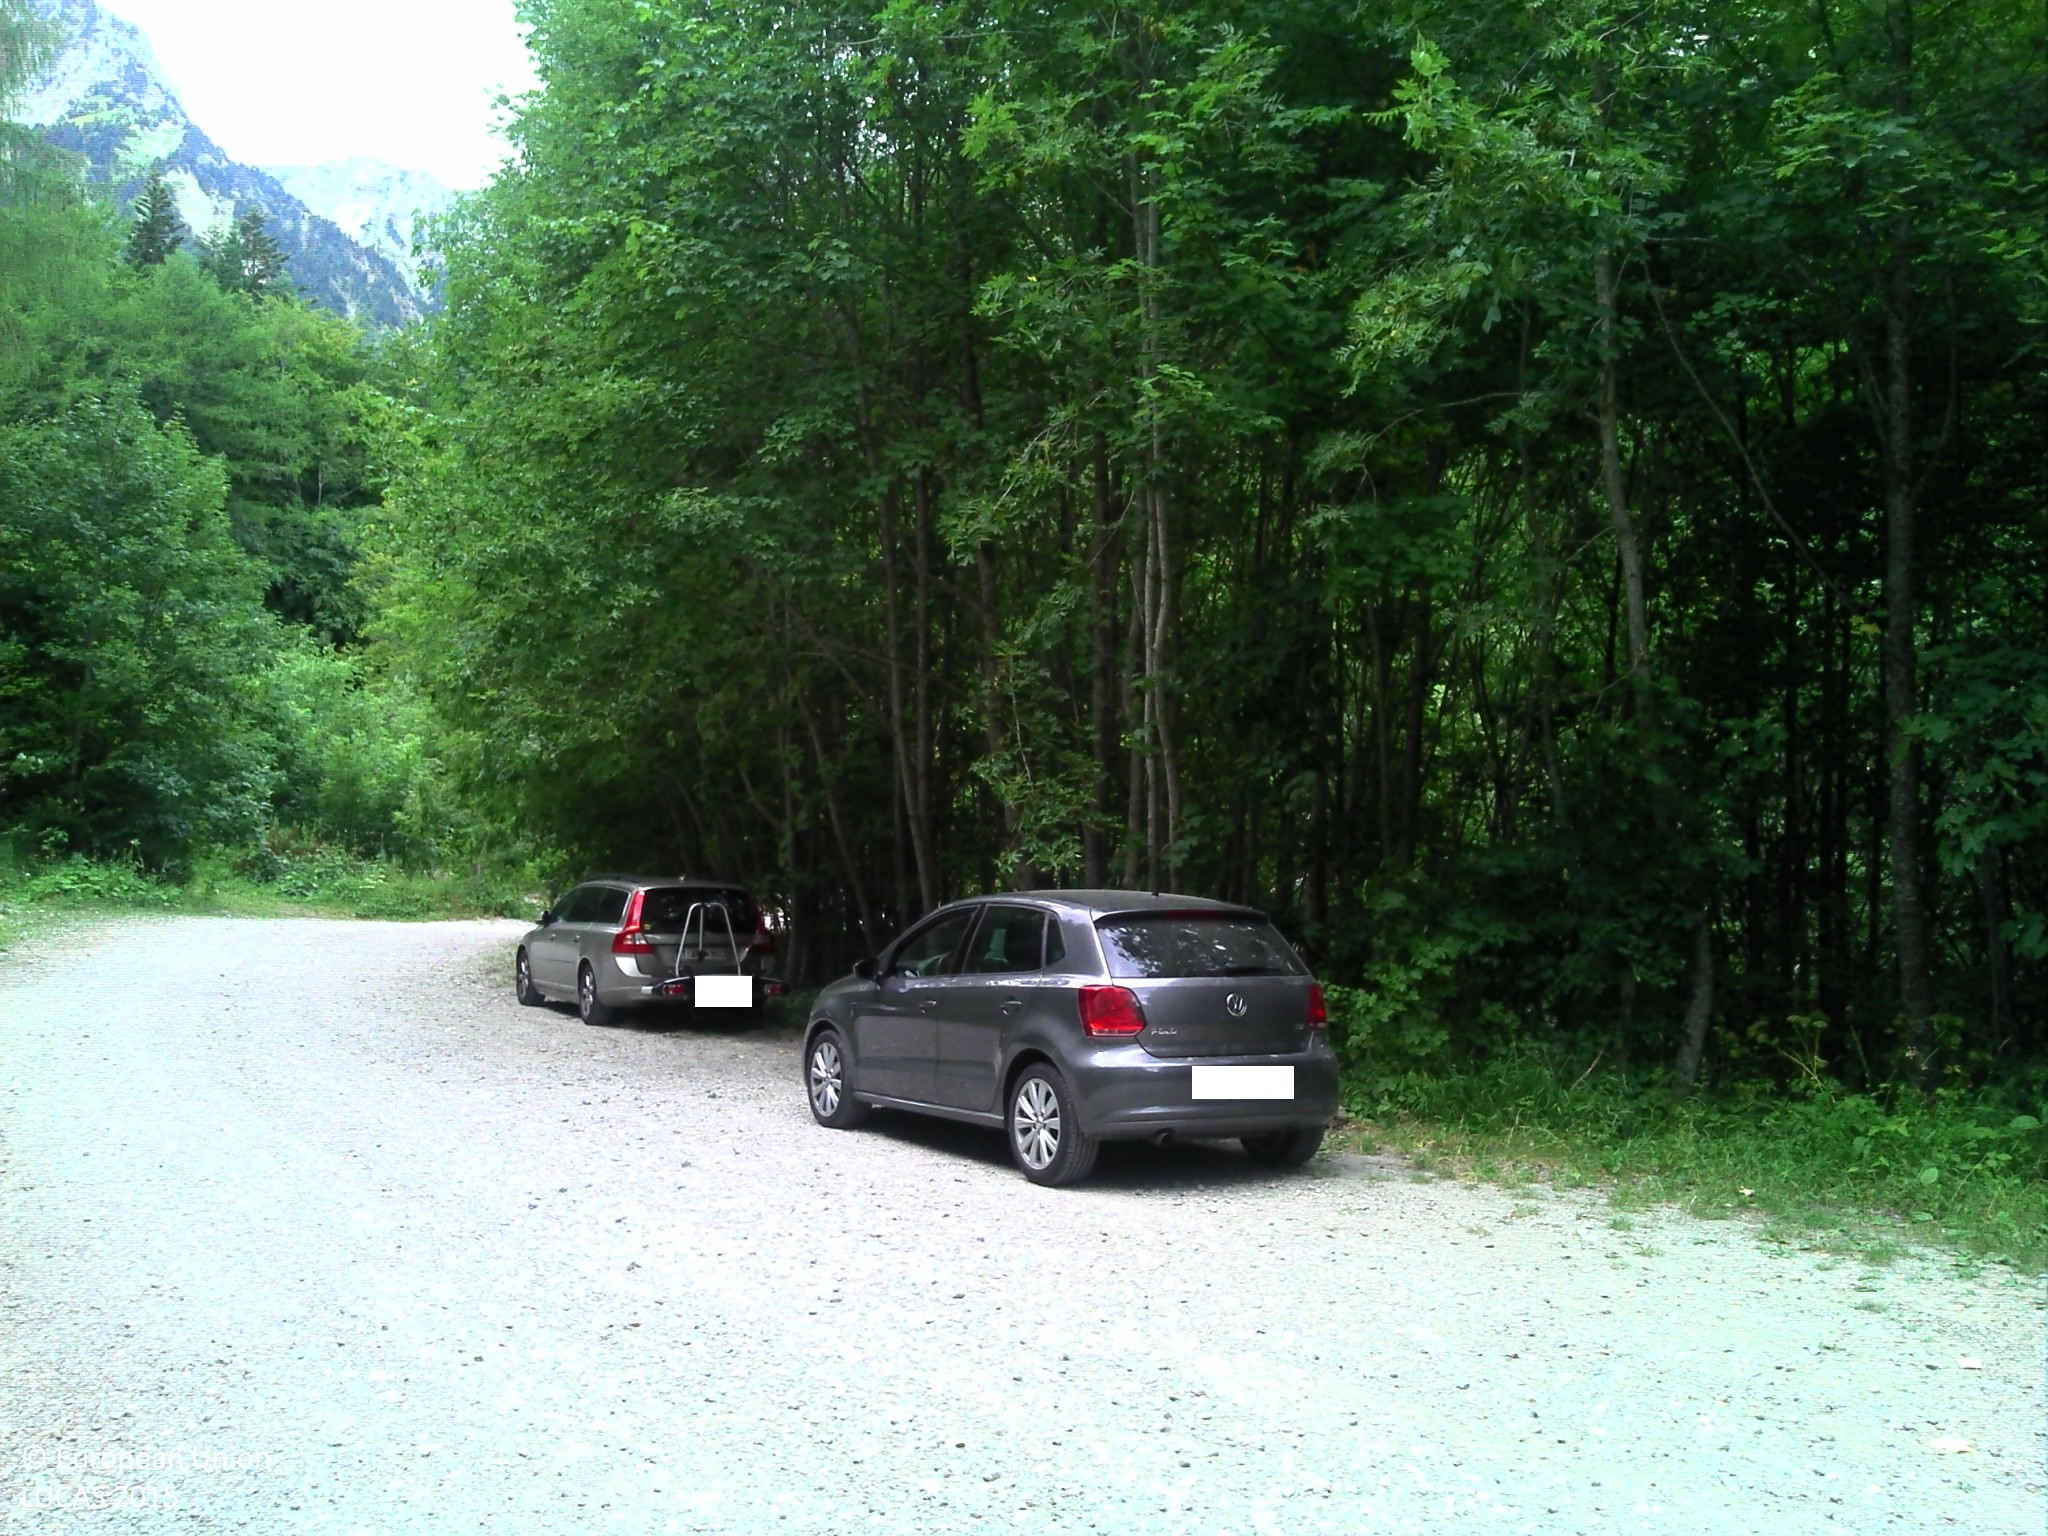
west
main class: Woodland
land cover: Other mixed woodland
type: alpine coniferous forest
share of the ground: > 75 %
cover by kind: coniferous forest trees 55 %, broadleaved forest trees 40 %, unconsolidated bare surface 5 %
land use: Semi-natural and natural areas not in use
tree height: > 5 m
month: July
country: FR
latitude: 44.8517
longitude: 5.5648
